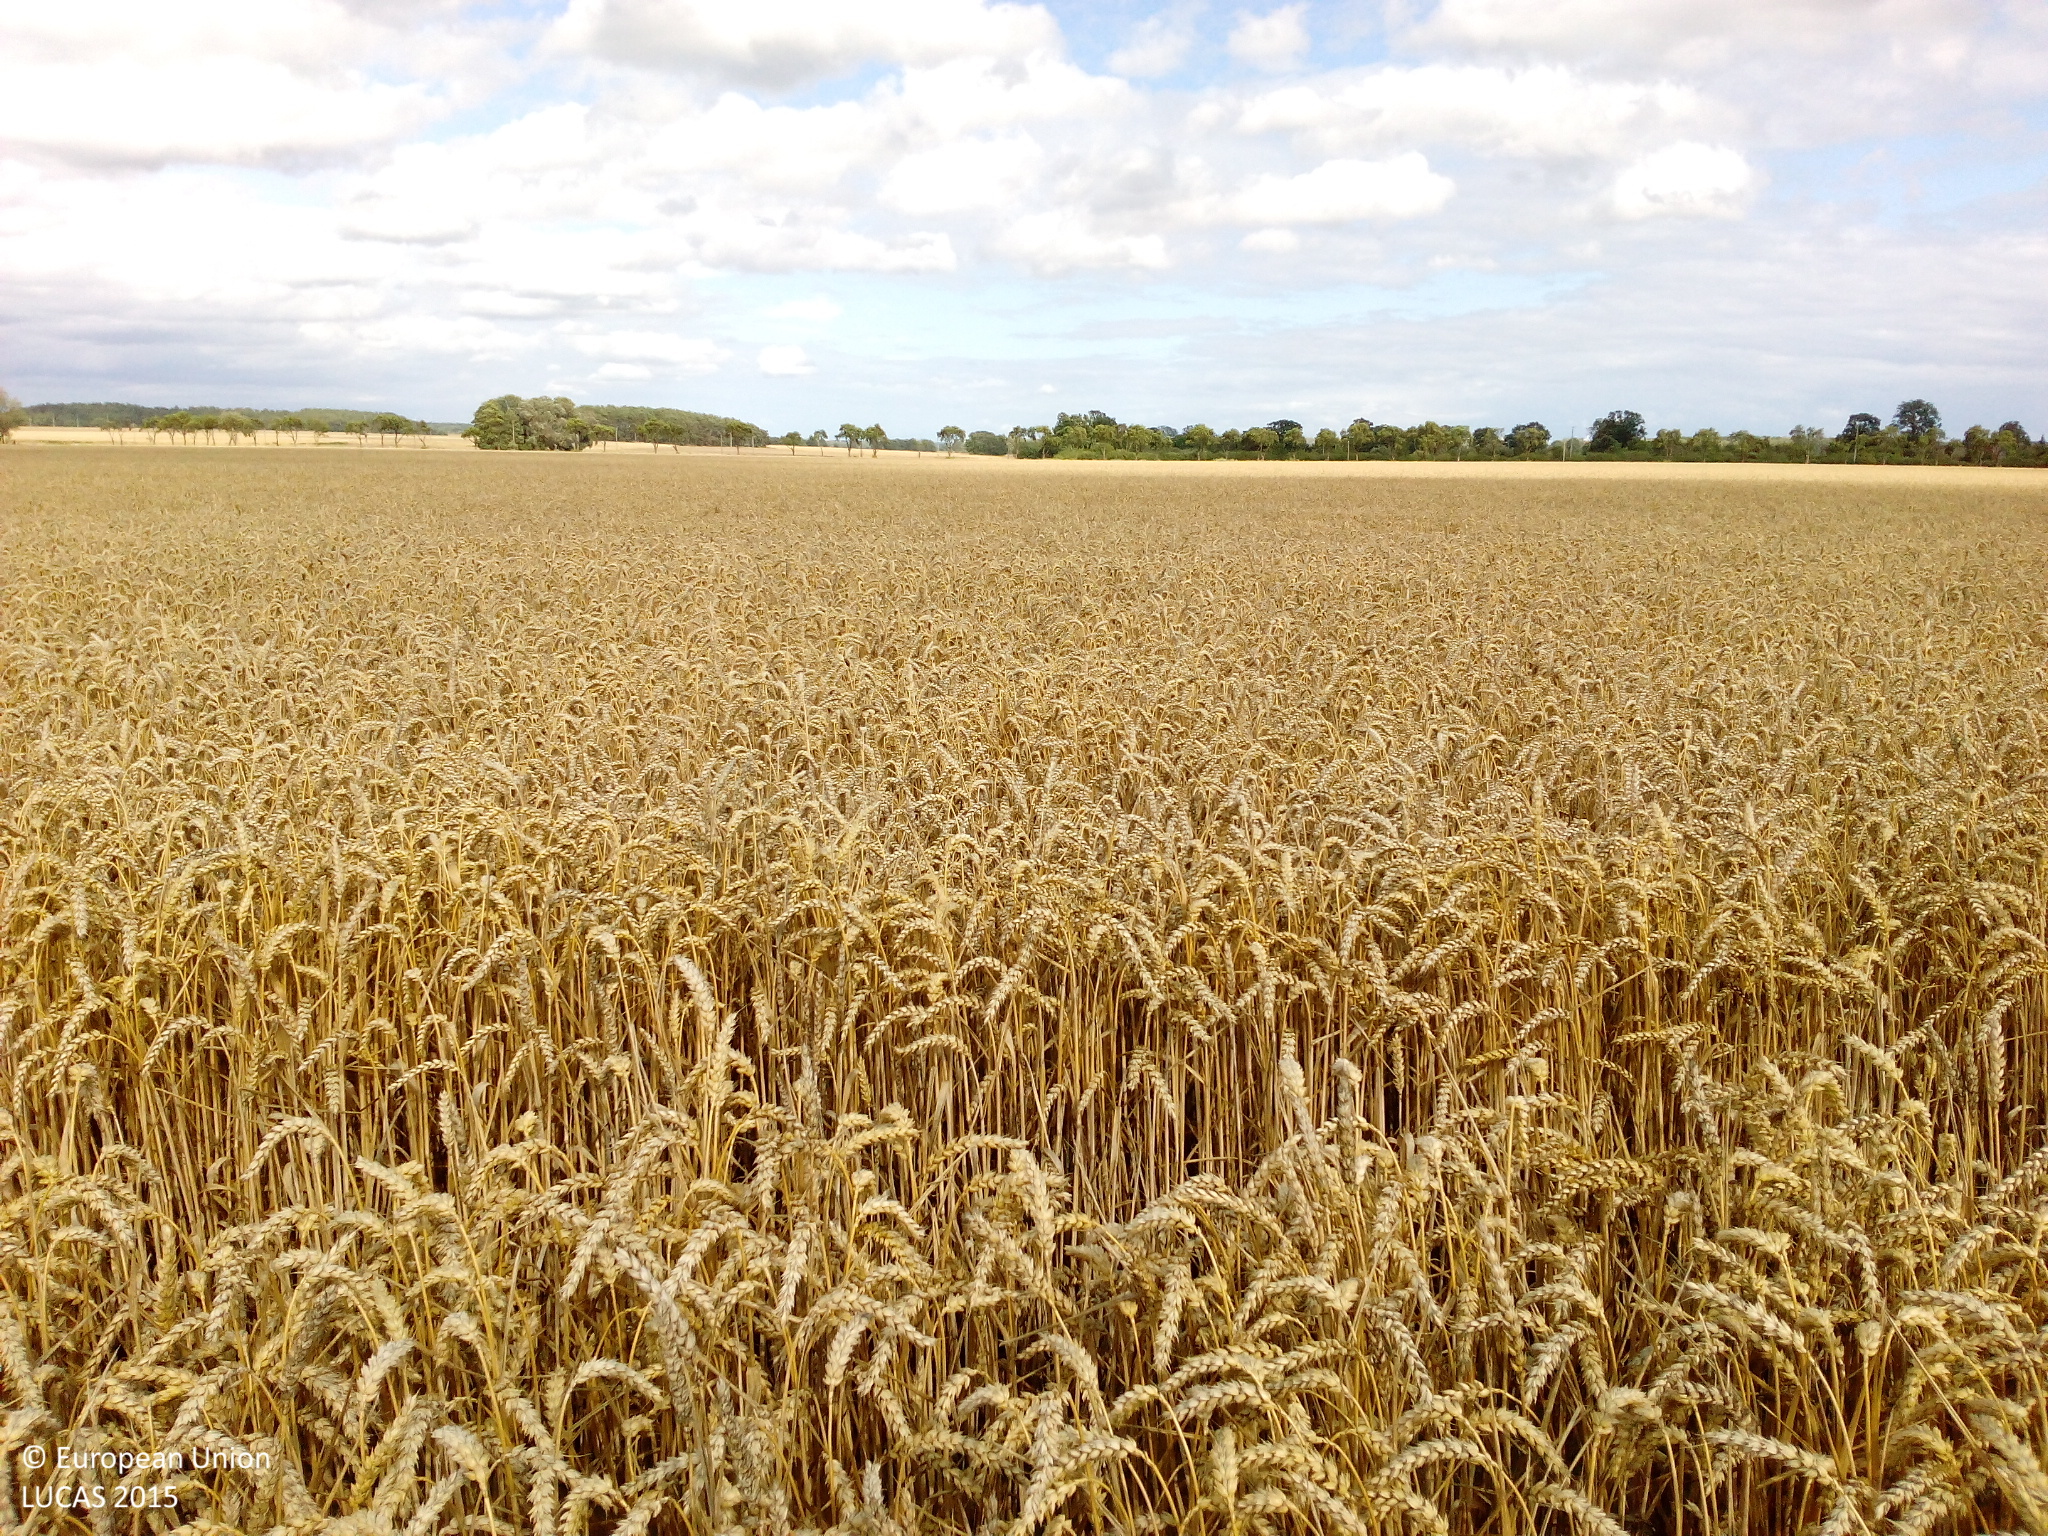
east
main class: Cropland
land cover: Common wheat
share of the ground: > 75 %
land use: Agriculture (excluding fallow land and kitchen gardens)
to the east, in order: Common wheat
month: July
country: DE
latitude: 53.1752
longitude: 11.6302
